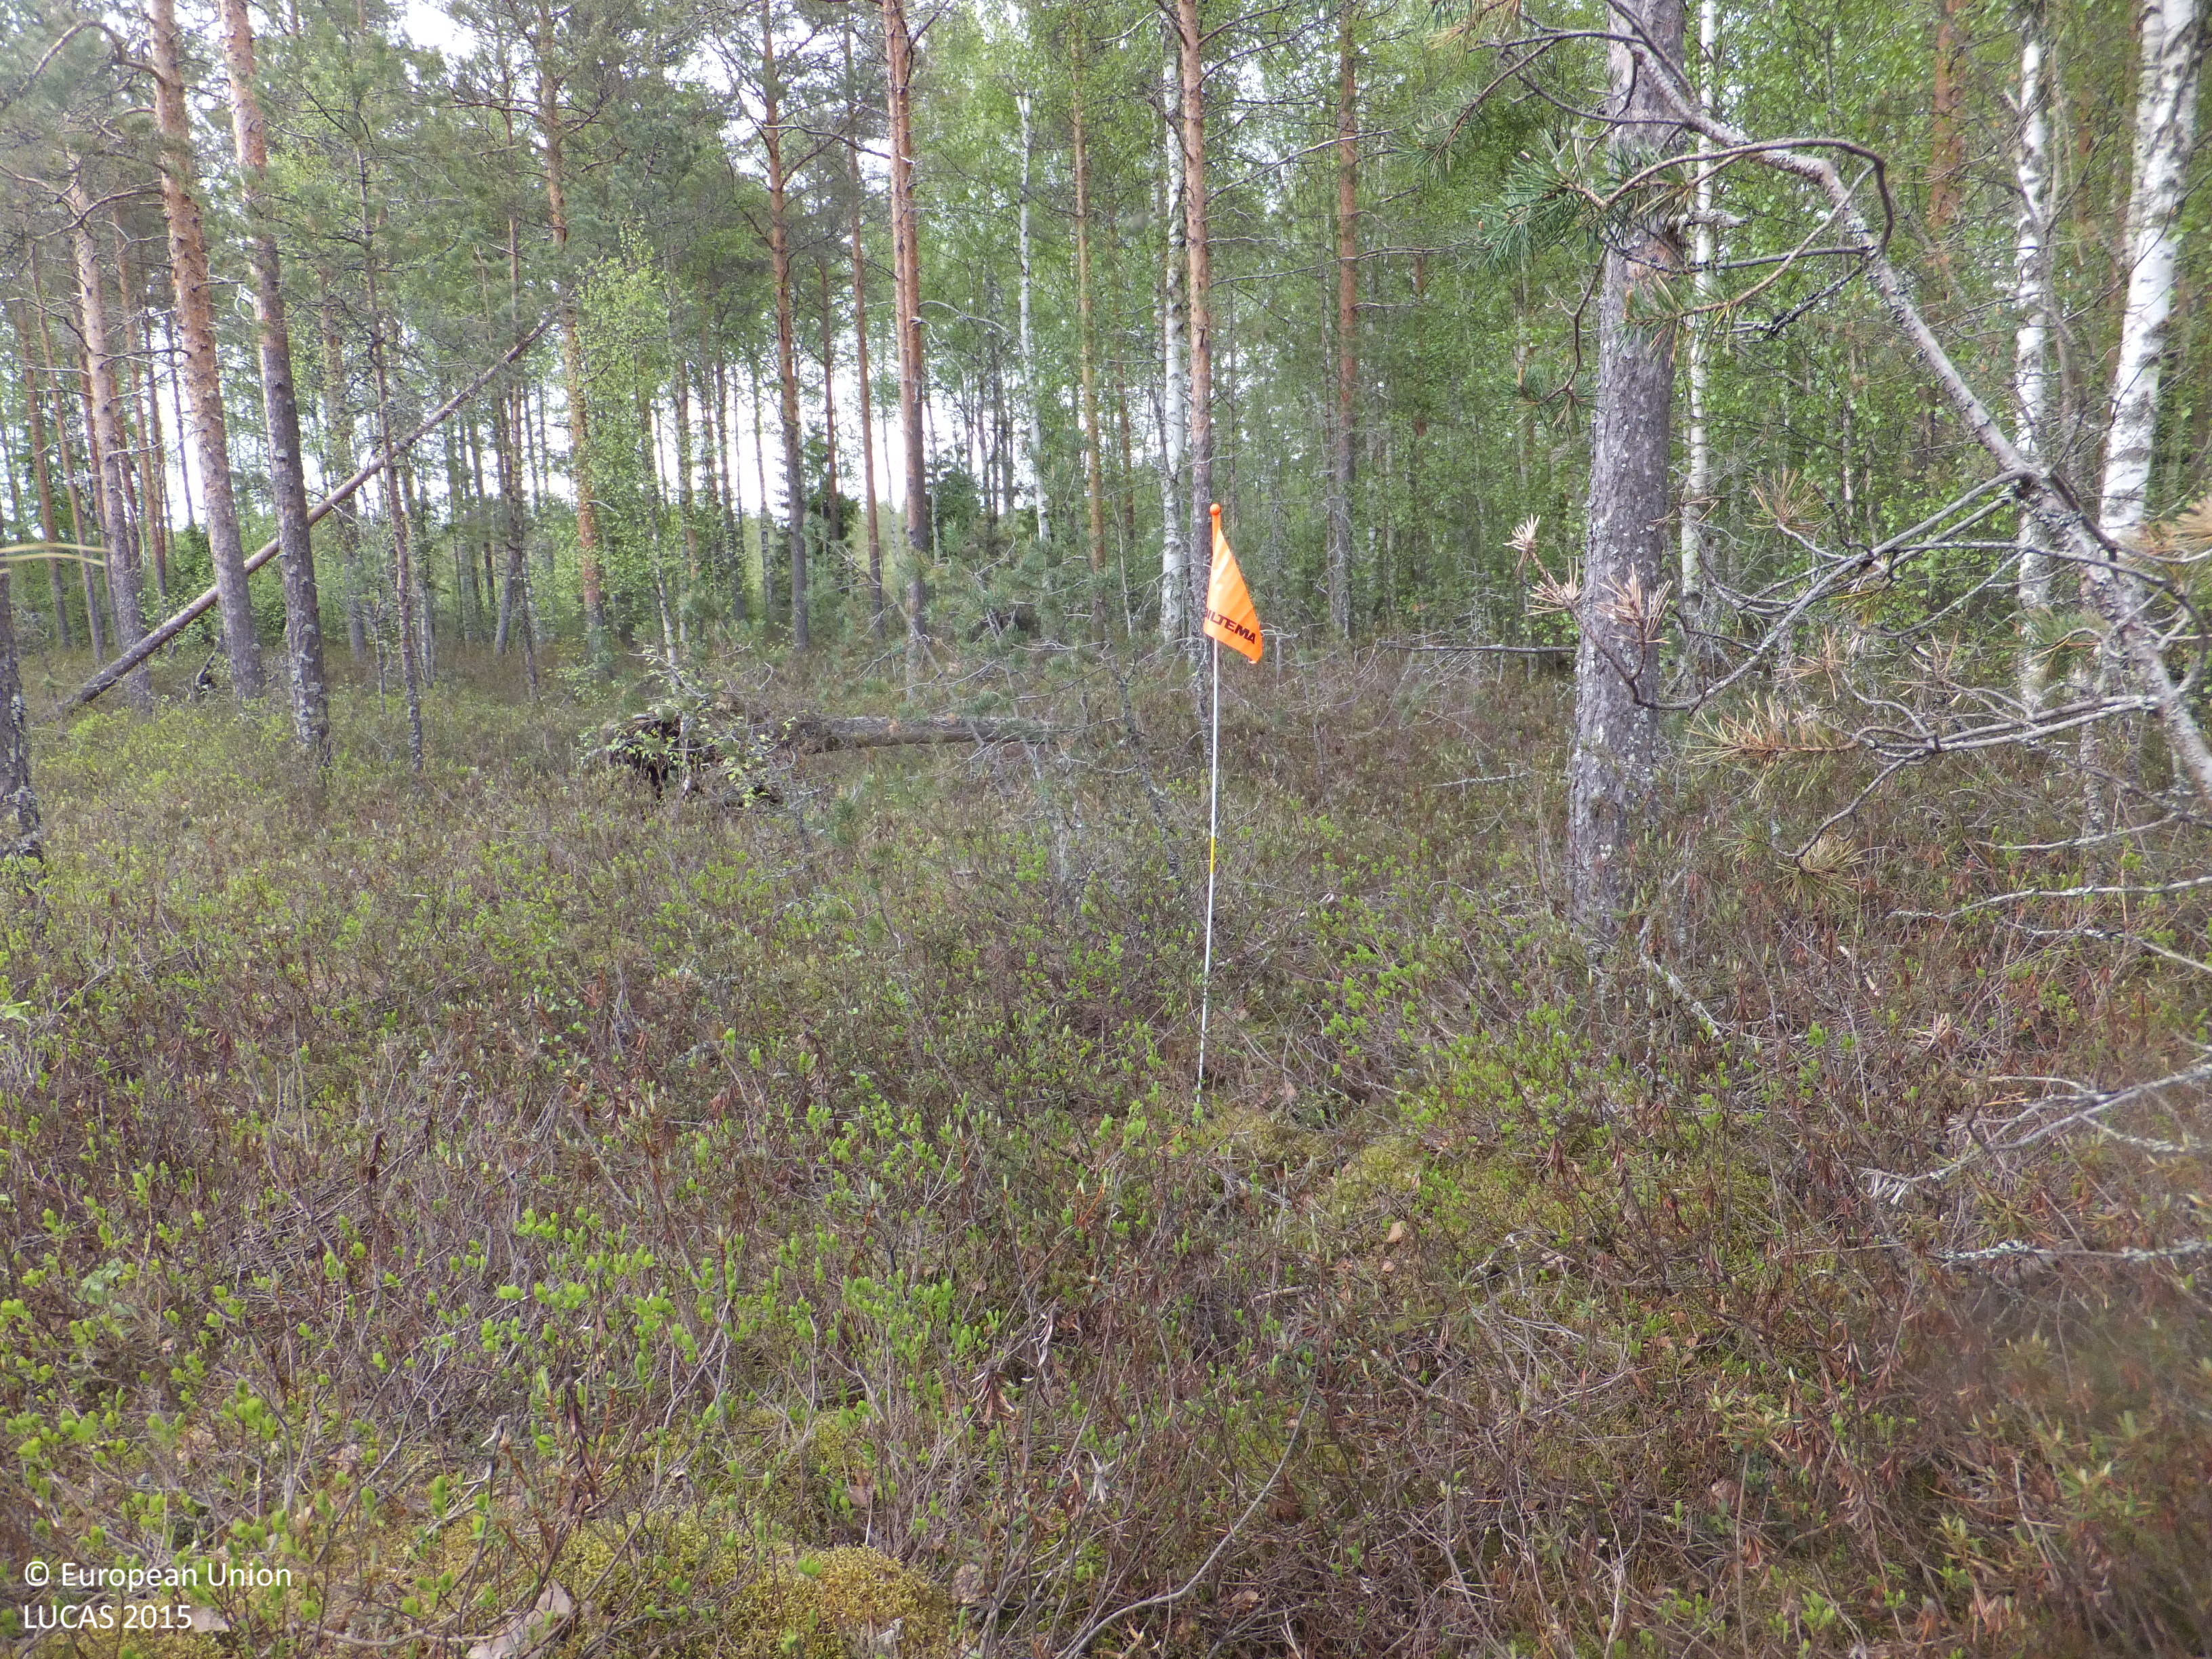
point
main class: Woodland
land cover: Pine dominated coniferous woodland
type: boreal forest
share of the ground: > 75 %
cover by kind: coniferous forest trees 80 %, shrubs 10 %, broadleaved forest trees 5 %, lichens and mosses 5 %
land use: Forestry
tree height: > 5 m
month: June
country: FI
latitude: 63.5470
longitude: 23.2365
